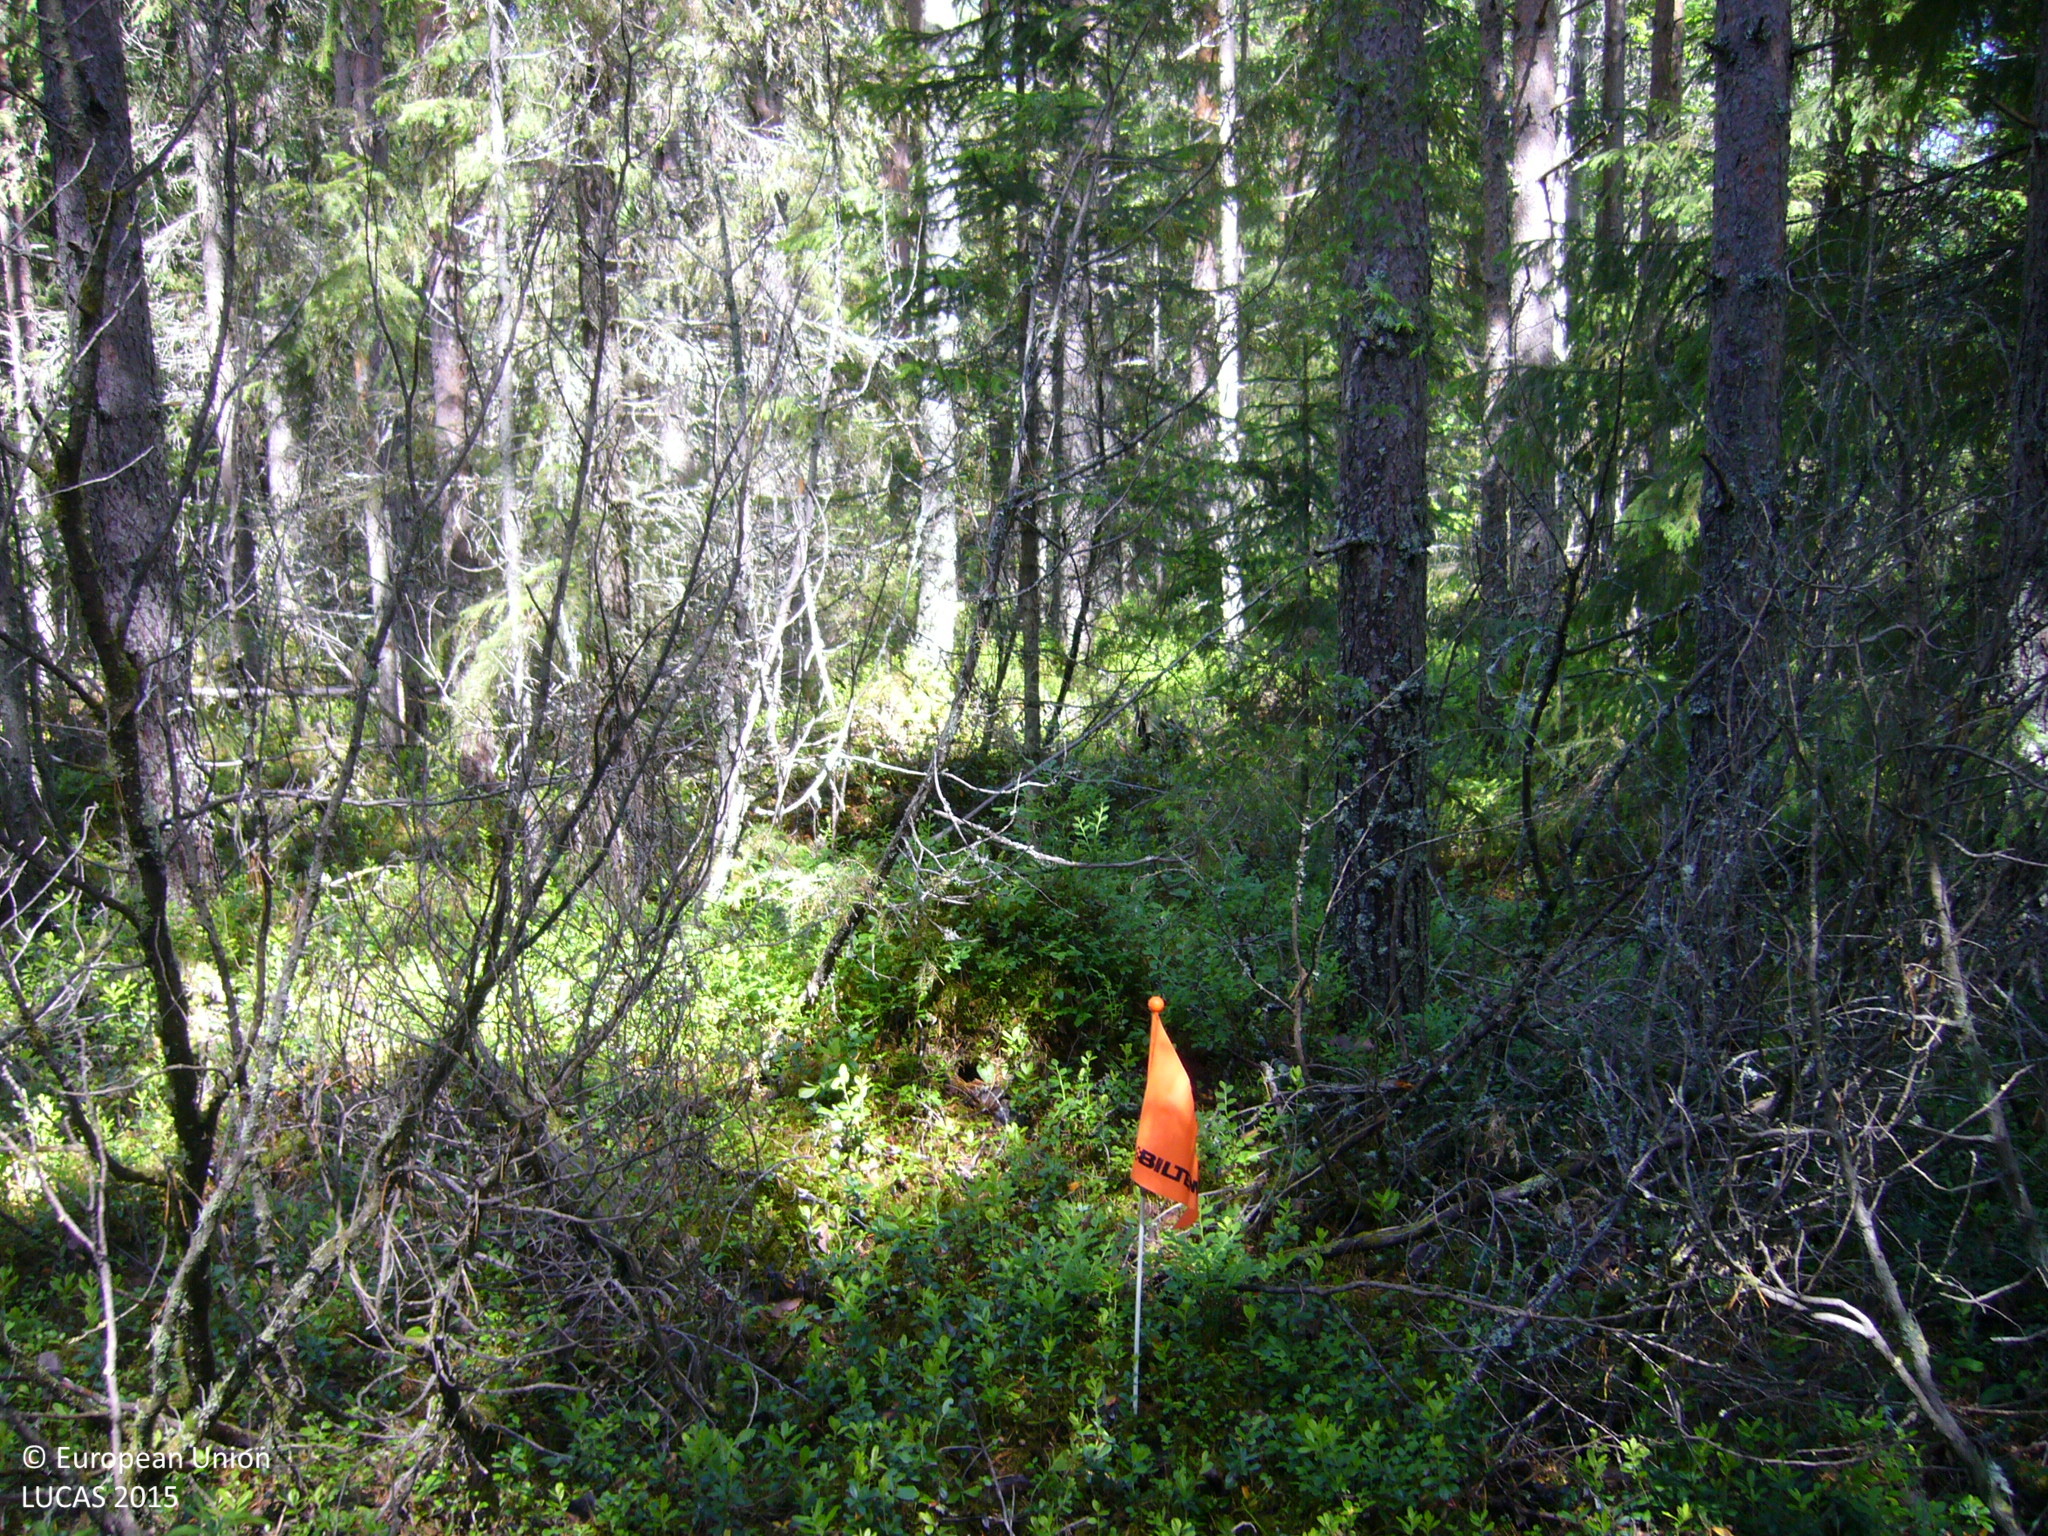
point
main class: Woodland
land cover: Pine dominated mixed woodland
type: boreal forest
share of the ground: > 75 %
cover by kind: coniferous forest trees 50 %, broadleaved forest trees 25 %, shrubs 25 %
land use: Forestry
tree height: > 5 m
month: July
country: FI
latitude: 63.5911
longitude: 26.0541
